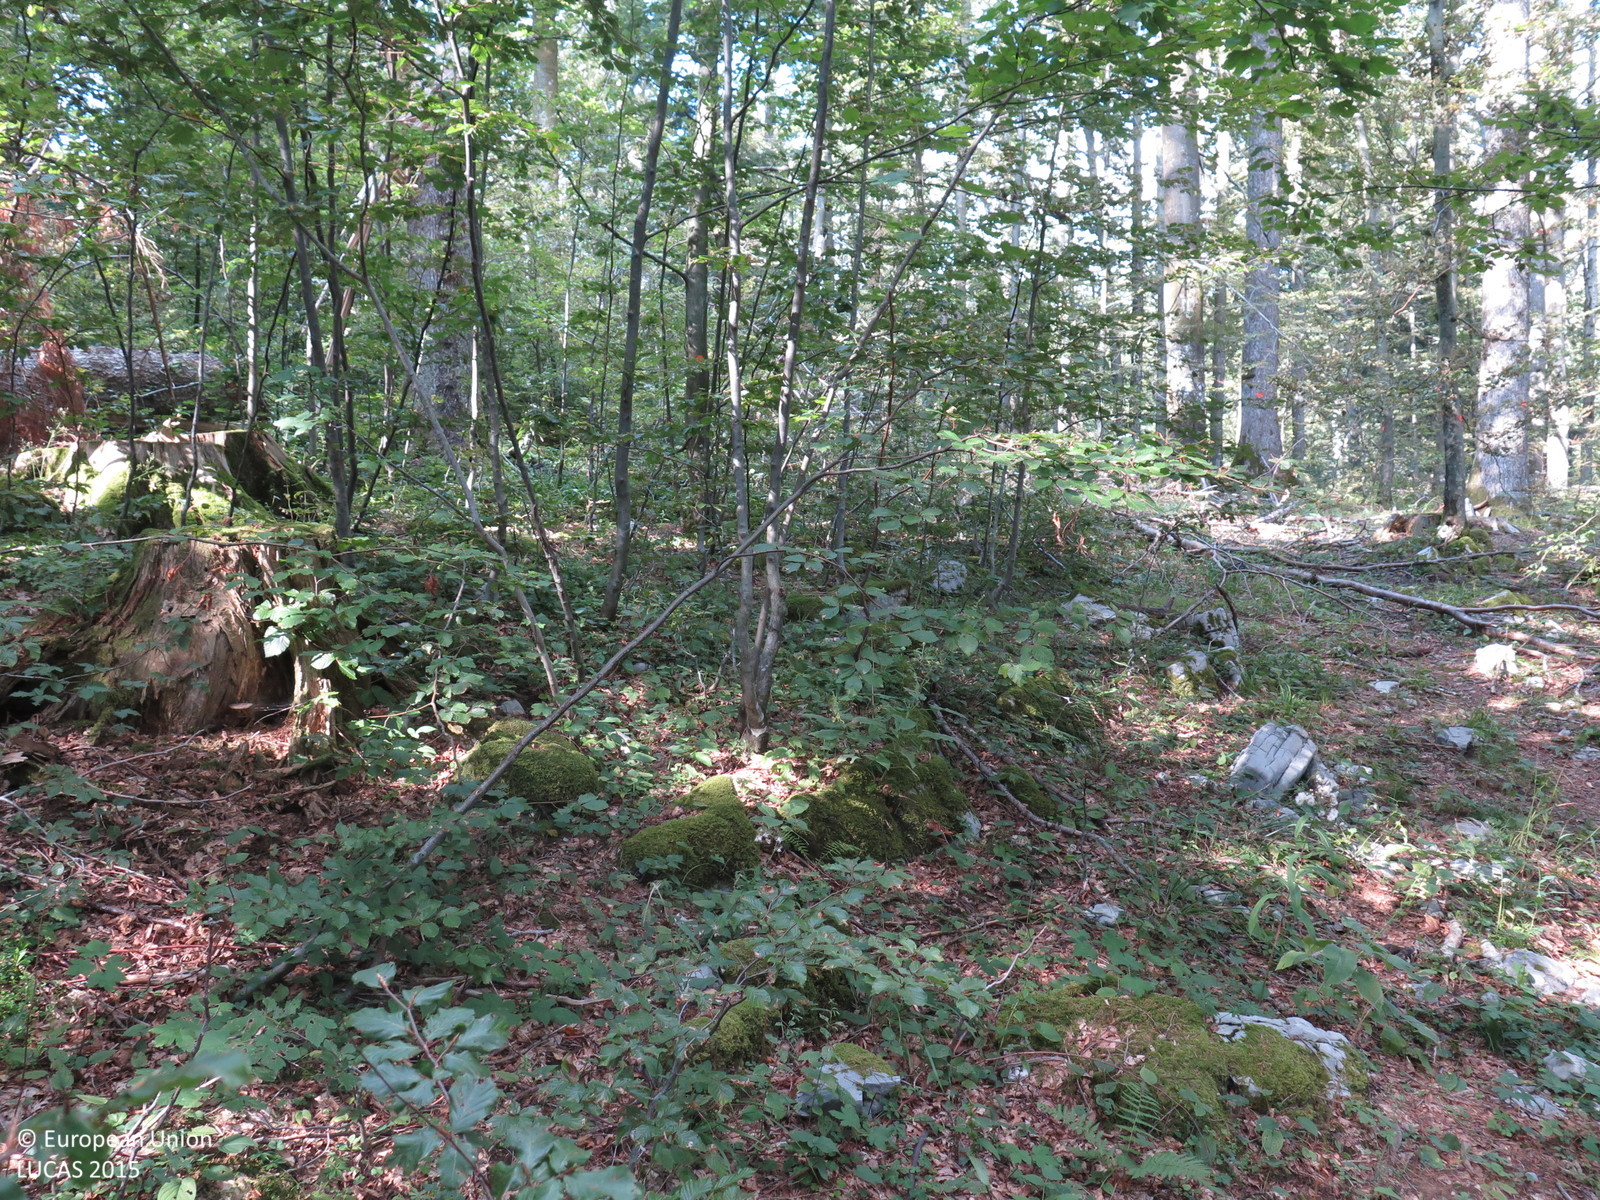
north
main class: Woodland
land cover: Other mixed woodland
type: alpine coniferous forest
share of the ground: > 75 %
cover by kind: coniferous forest trees 75 %, broadleaved forest trees 25 %
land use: Forestry
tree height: > 5 m
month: September
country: HR
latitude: 45.4151
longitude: 14.7616
